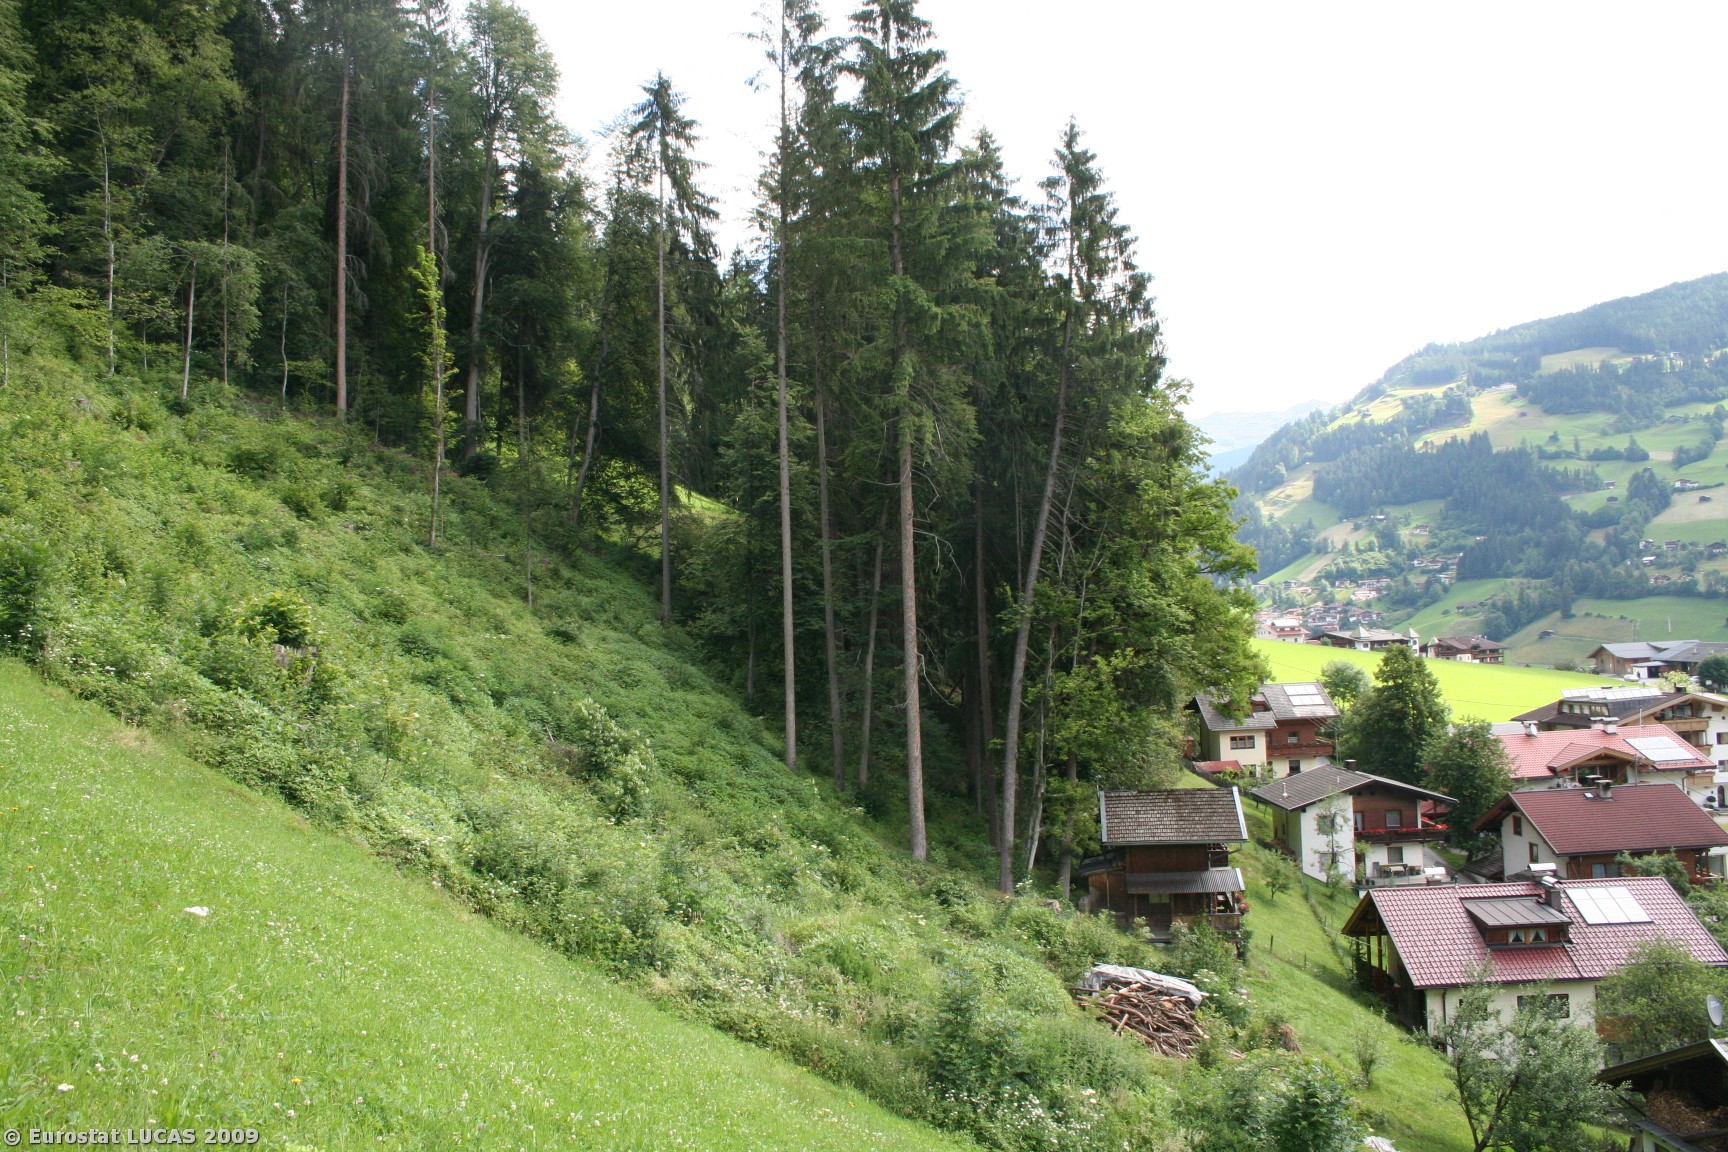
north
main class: Grassland
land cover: Grassland without tree/shrub cover
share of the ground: > 75 %
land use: Agriculture (excluding fallow land and kitchen gardens)
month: June
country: AT
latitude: 47.1996
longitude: 11.8596
